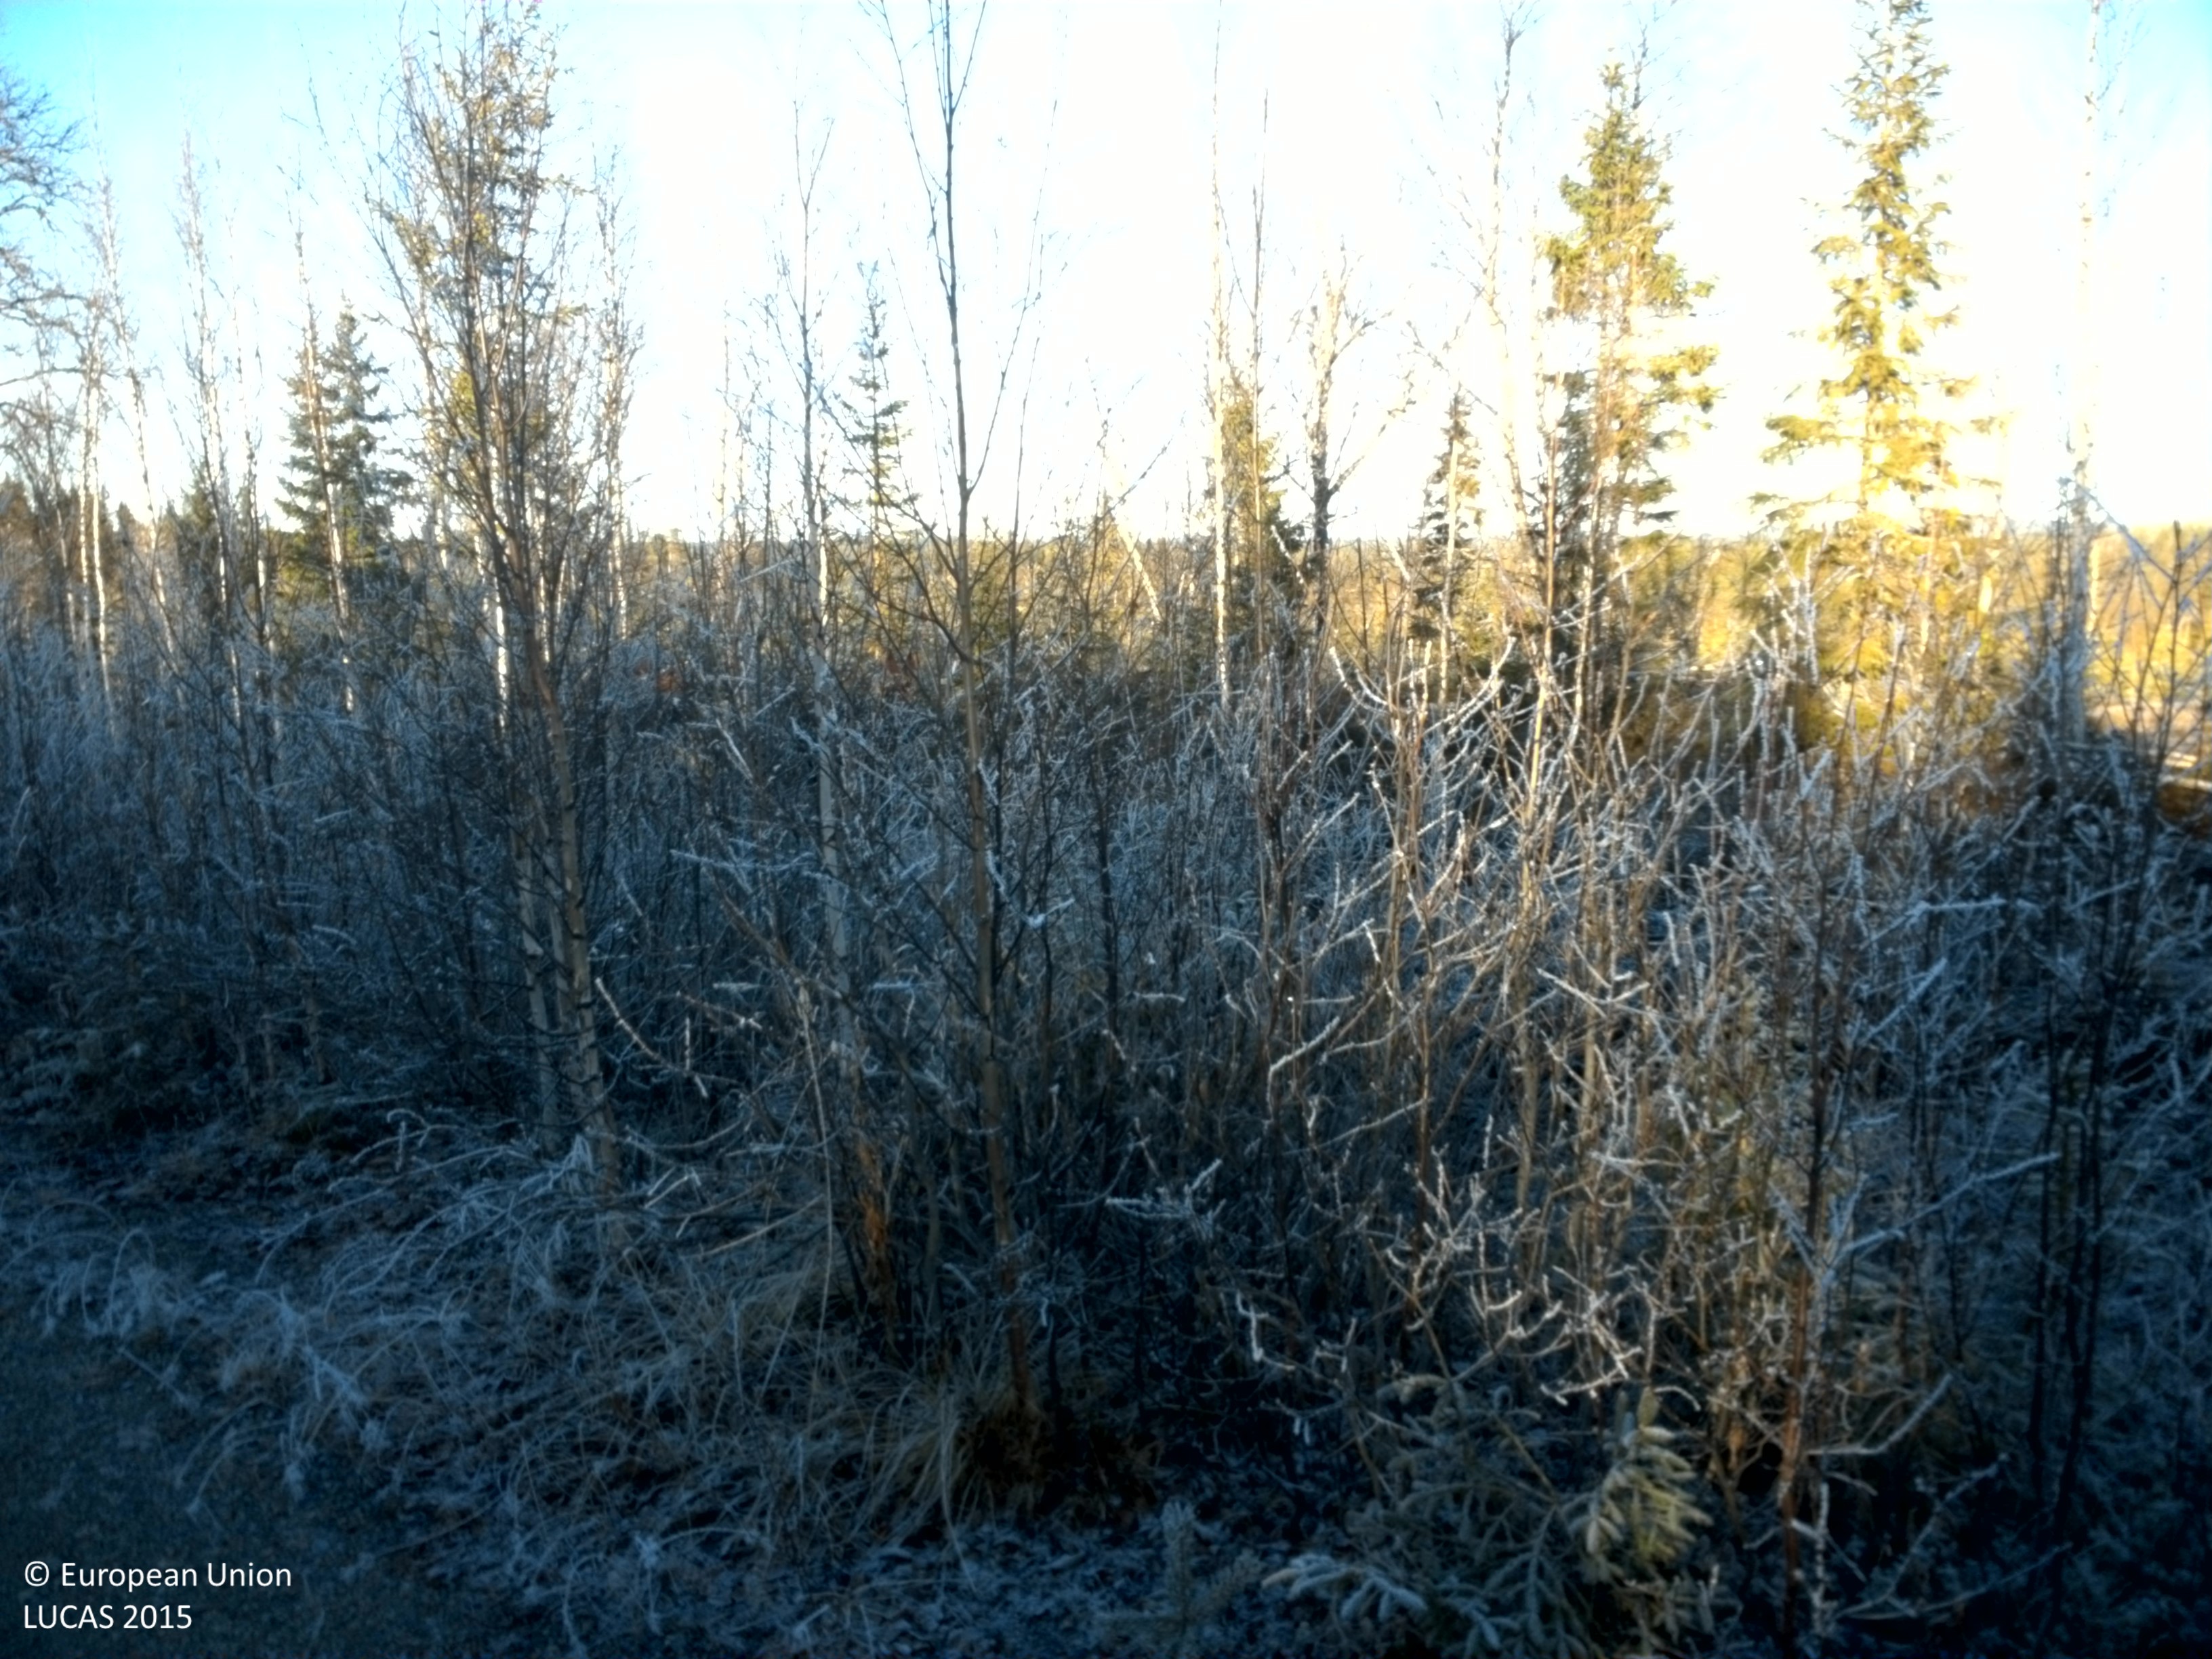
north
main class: Artificial land
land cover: Non built-up linear features
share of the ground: > 75 %
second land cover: Grassland without tree/shrub cover
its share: 10 - 25 %
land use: Road transport
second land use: Forestry
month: October
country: SE
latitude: 64.4406
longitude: 16.6363
